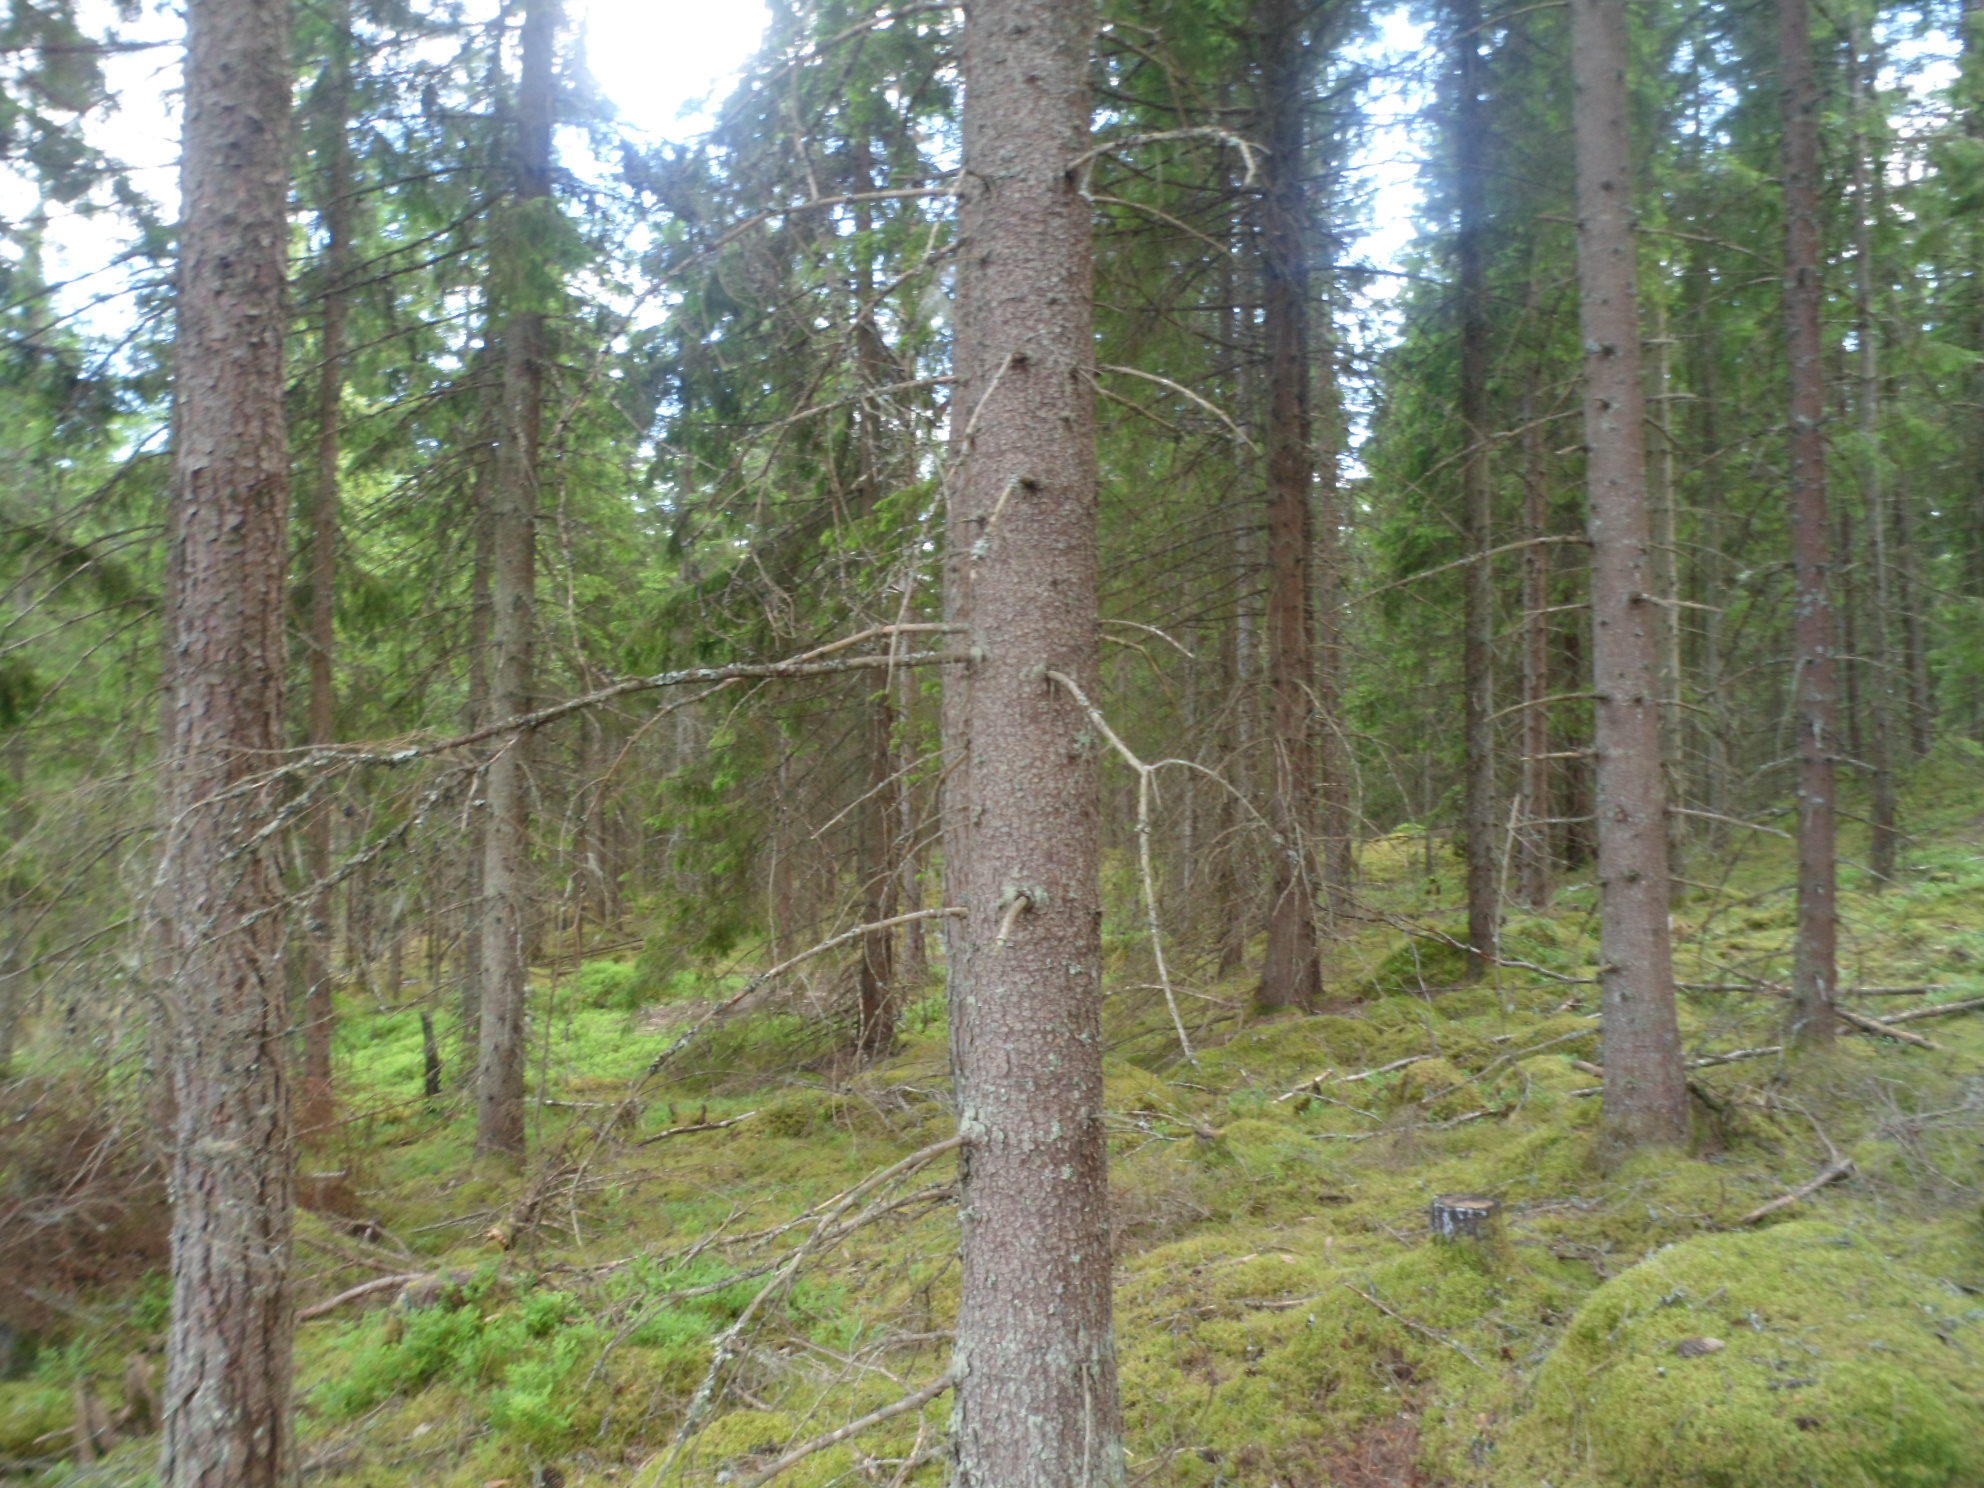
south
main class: Woodland
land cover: Spruce dominated coniferous woodland
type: boreal forest
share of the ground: 50 - 75 %
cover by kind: coniferous forest trees 60 %, shrubs 15 %, lichens and mosses 15 %, broadleaved forest trees 5 %, herbaceous plants 5 %
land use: Forestry
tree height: > 5 m
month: July
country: SE
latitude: 57.5354
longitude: 14.3885
